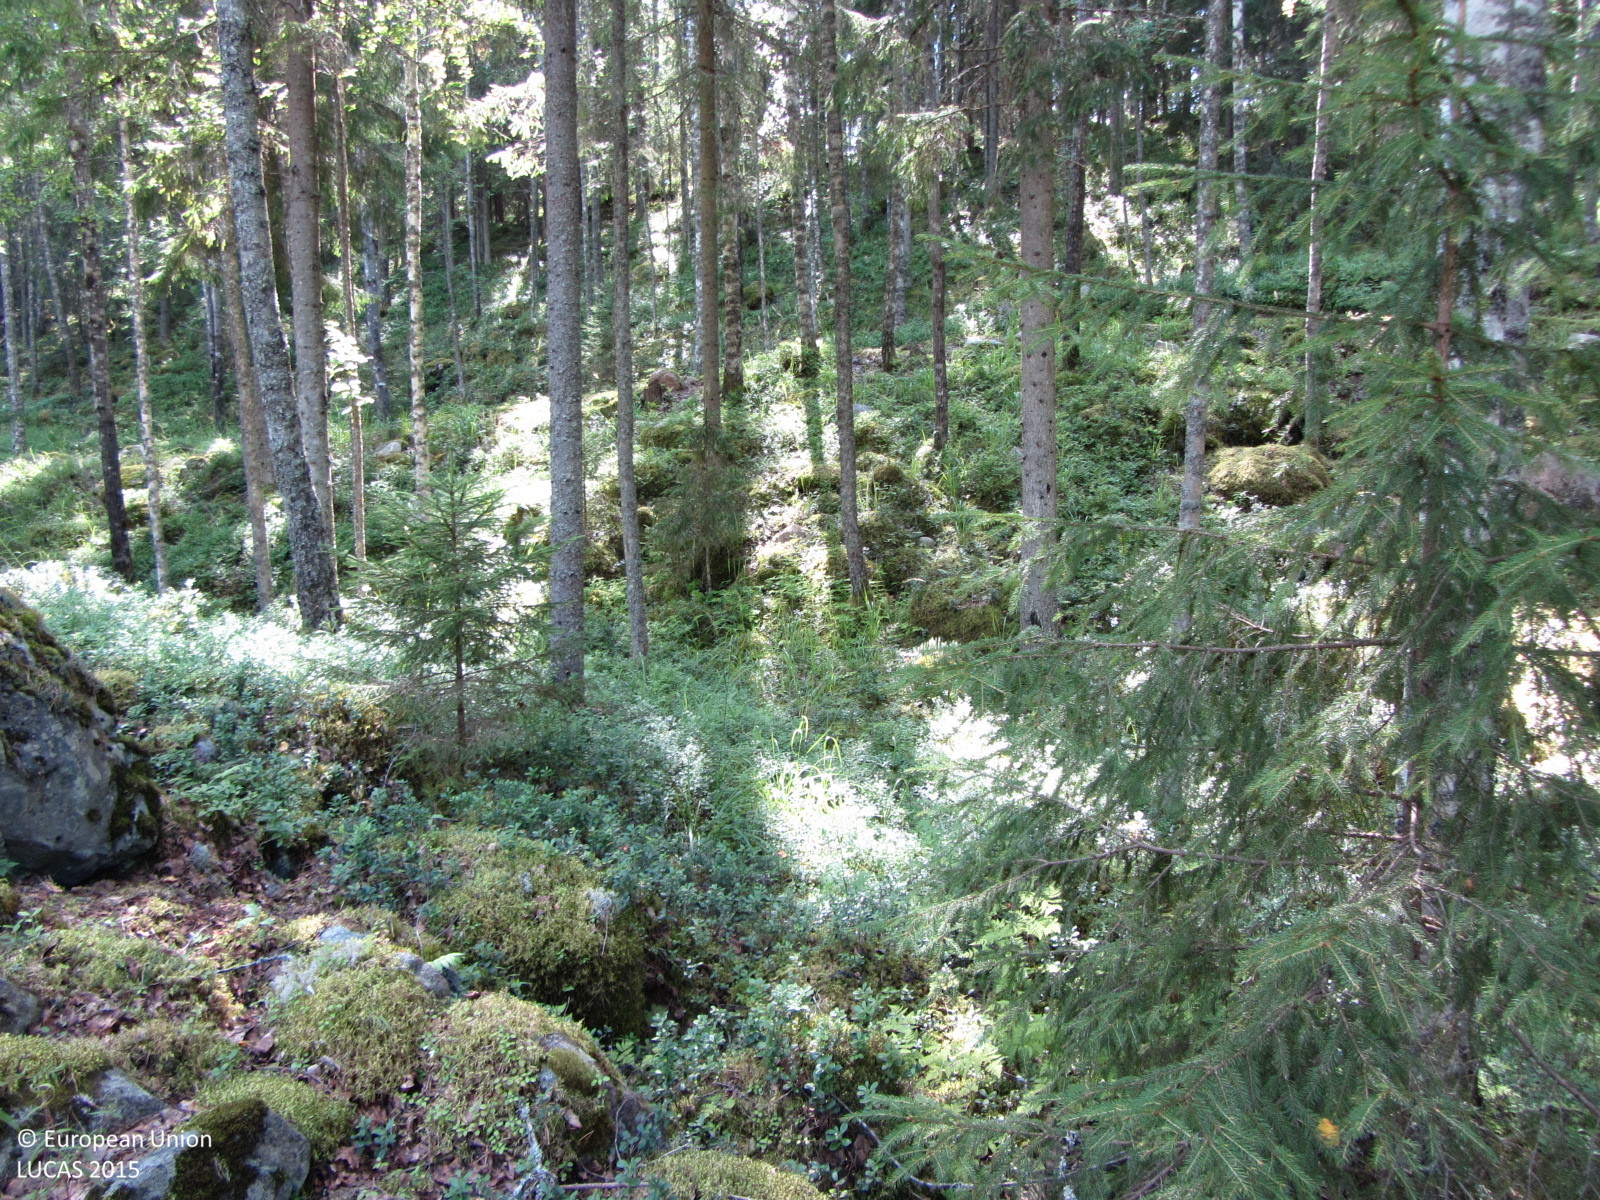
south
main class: Woodland
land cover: Pine dominated mixed woodland
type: boreal forest
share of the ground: 50 - 75 %
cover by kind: coniferous forest trees 30 %, broadleaved forest trees 30 %, shrubs 20 %, lichens and mosses 15 %, unconsolidated bare surface 5 %
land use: Forestry
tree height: > 5 m
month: July
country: FI
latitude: 60.6311
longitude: 24.3790
